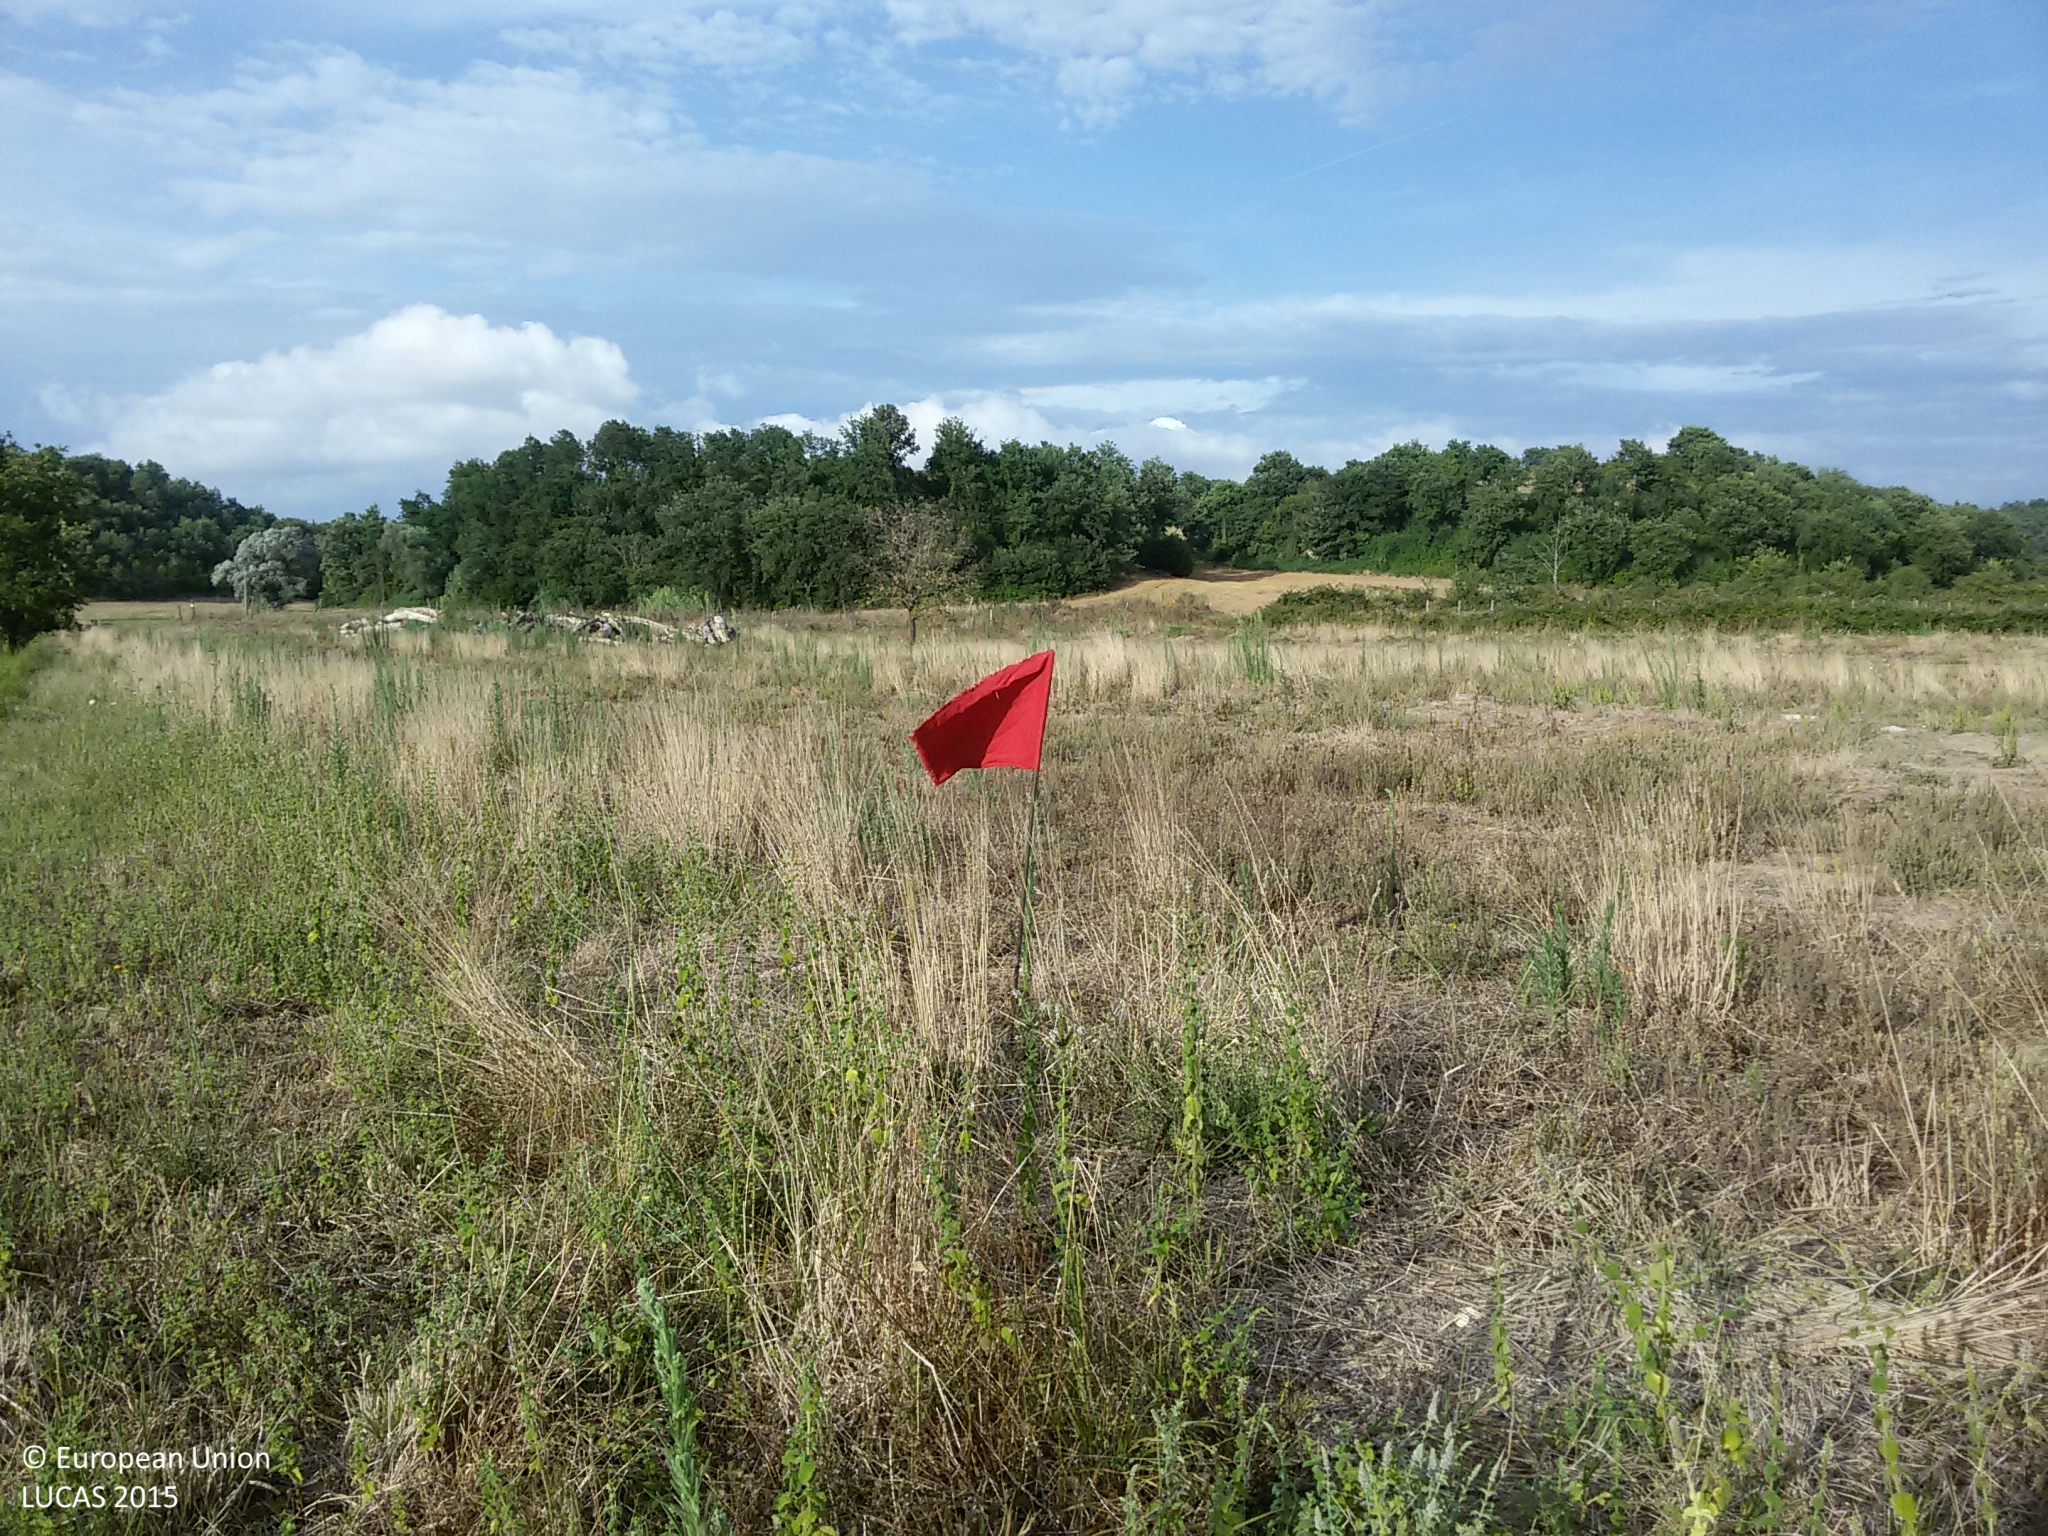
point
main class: Grassland
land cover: Grassland without tree/shrub cover
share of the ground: > 75 %
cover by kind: herbaceous plants 95 %, unconsolidated bare surface 5 %
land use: Agriculture (excluding fallow land and kitchen gardens)
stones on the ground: < 10 %
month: August
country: IT
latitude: 42.6054
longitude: 11.5914
